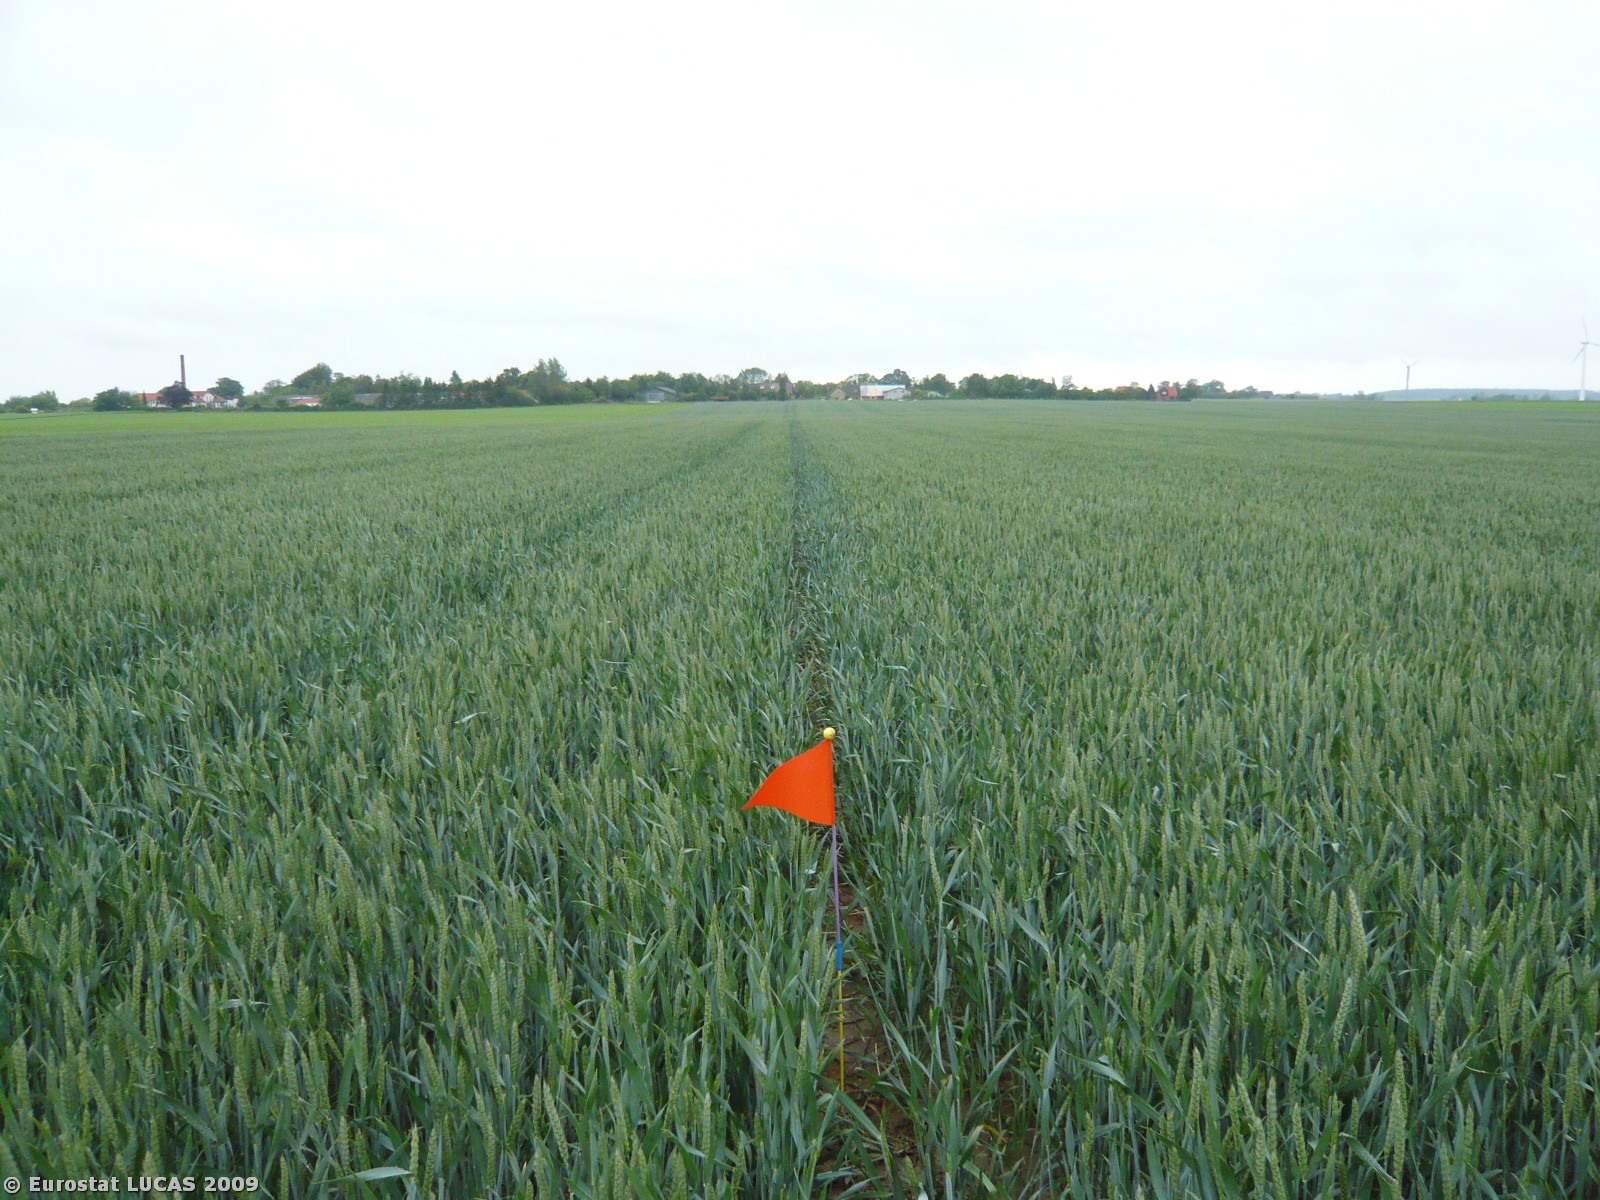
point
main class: Cropland
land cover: Common wheat
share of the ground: > 75 %
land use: Agriculture (excluding fallow land and kitchen gardens)
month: June
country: DK
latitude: 54.8624
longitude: 11.8216
